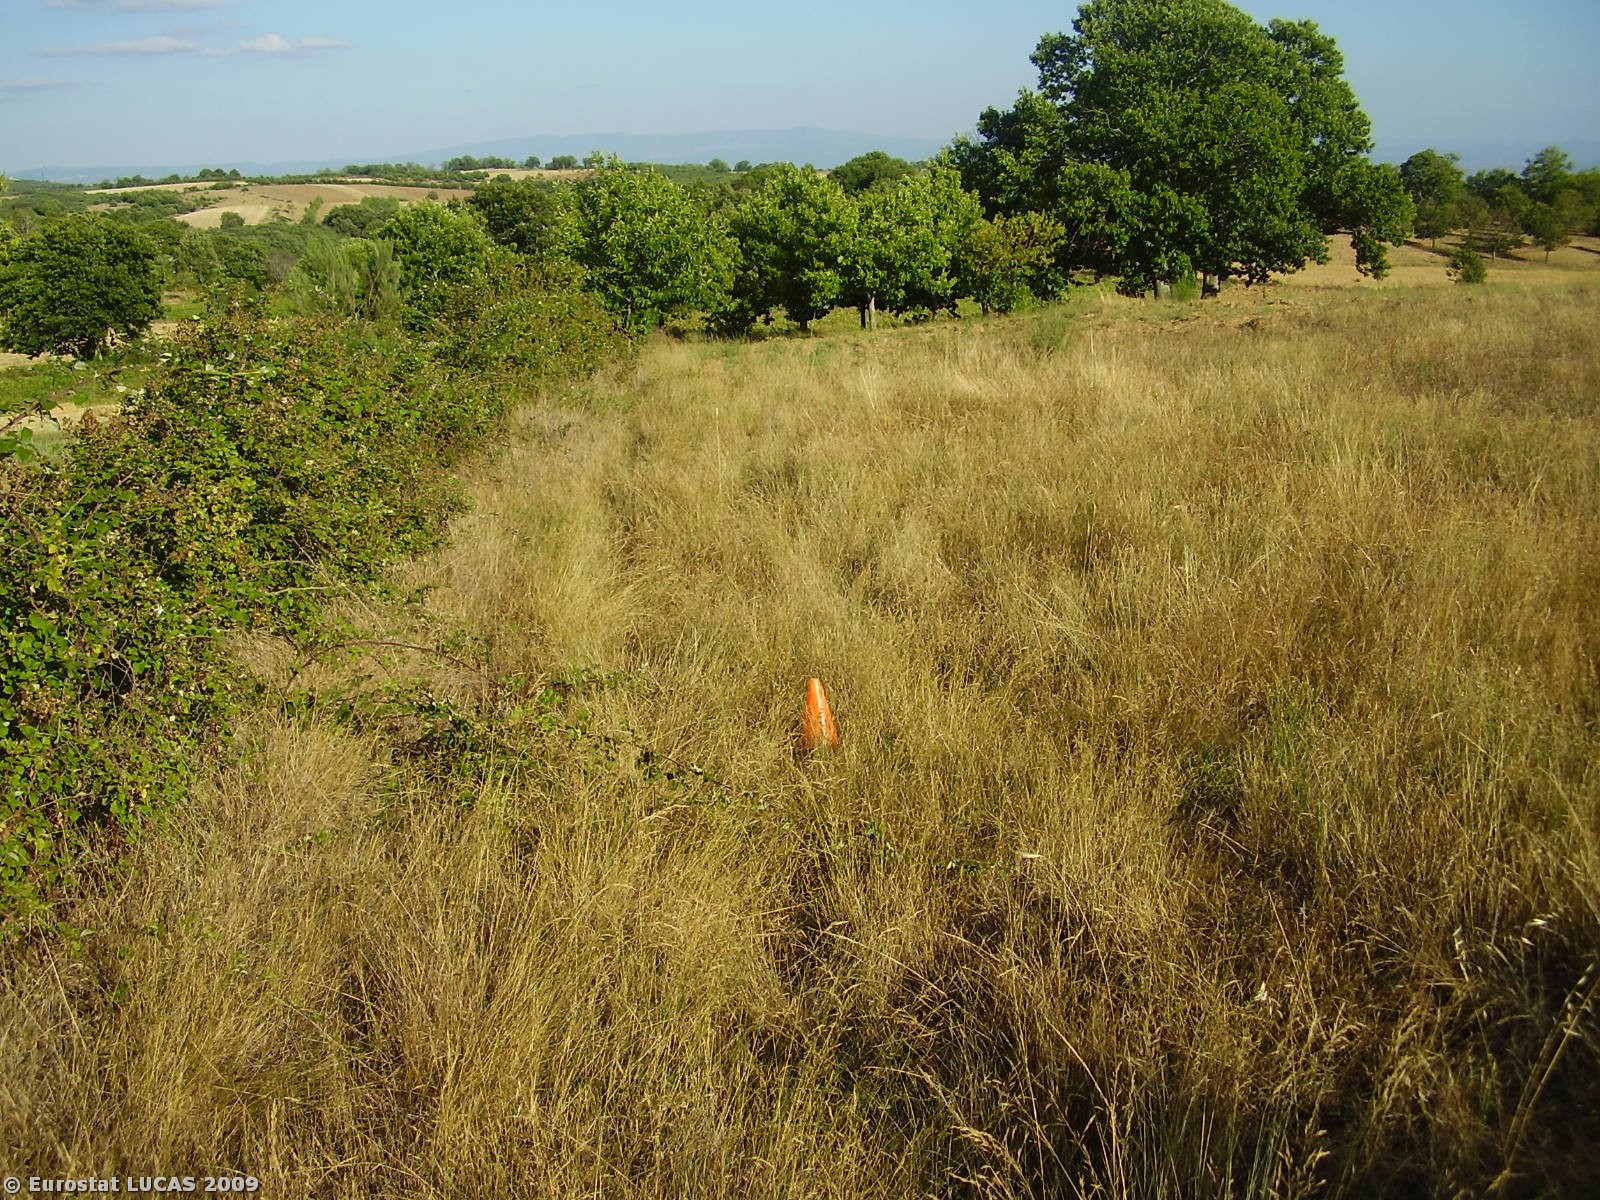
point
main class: Grassland
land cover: Spontaneously vegetated surfaces
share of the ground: > 75 %
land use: Unused
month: July
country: PT
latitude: 41.6887
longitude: -7.3920
